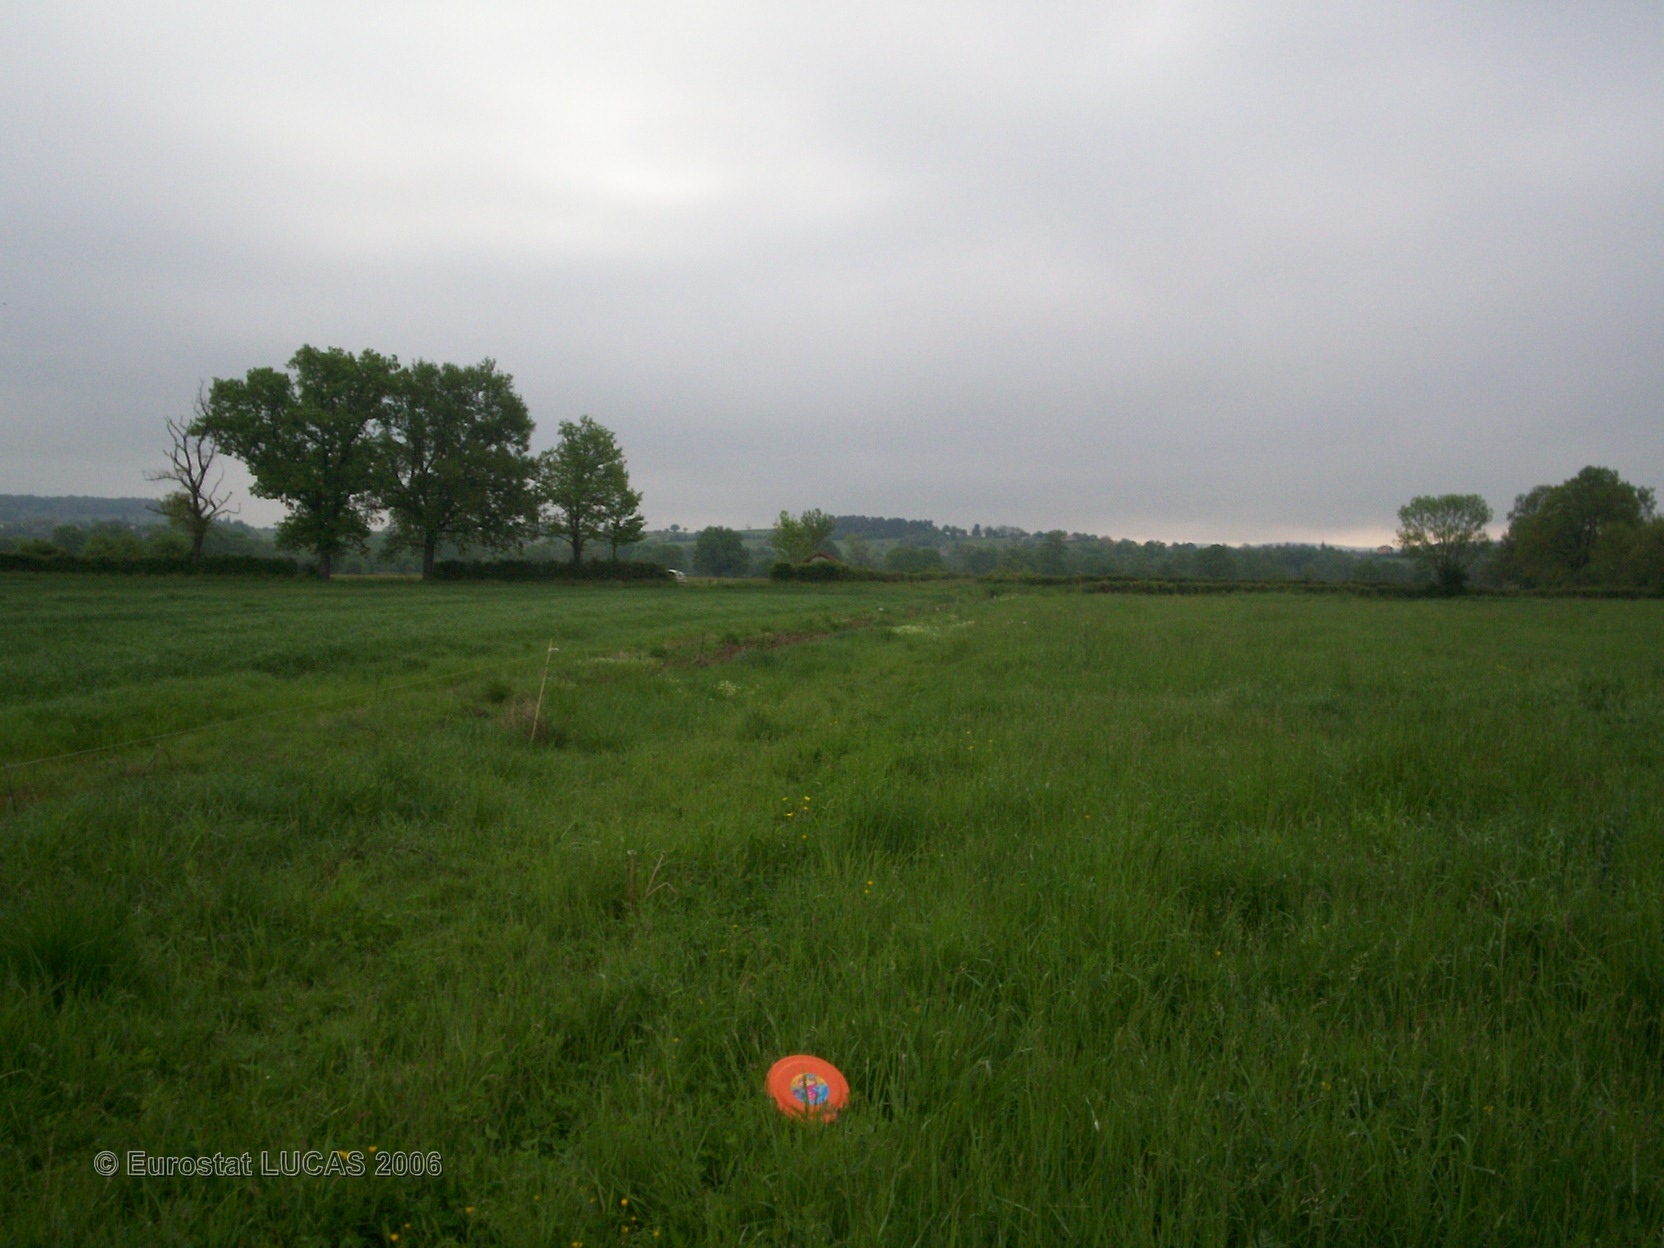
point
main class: Grassland
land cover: Grassland without tree/shrub cover
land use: Agriculture (excluding fallow land and kitchen gardens)
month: May
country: FR
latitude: 46.5431
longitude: 4.6679
